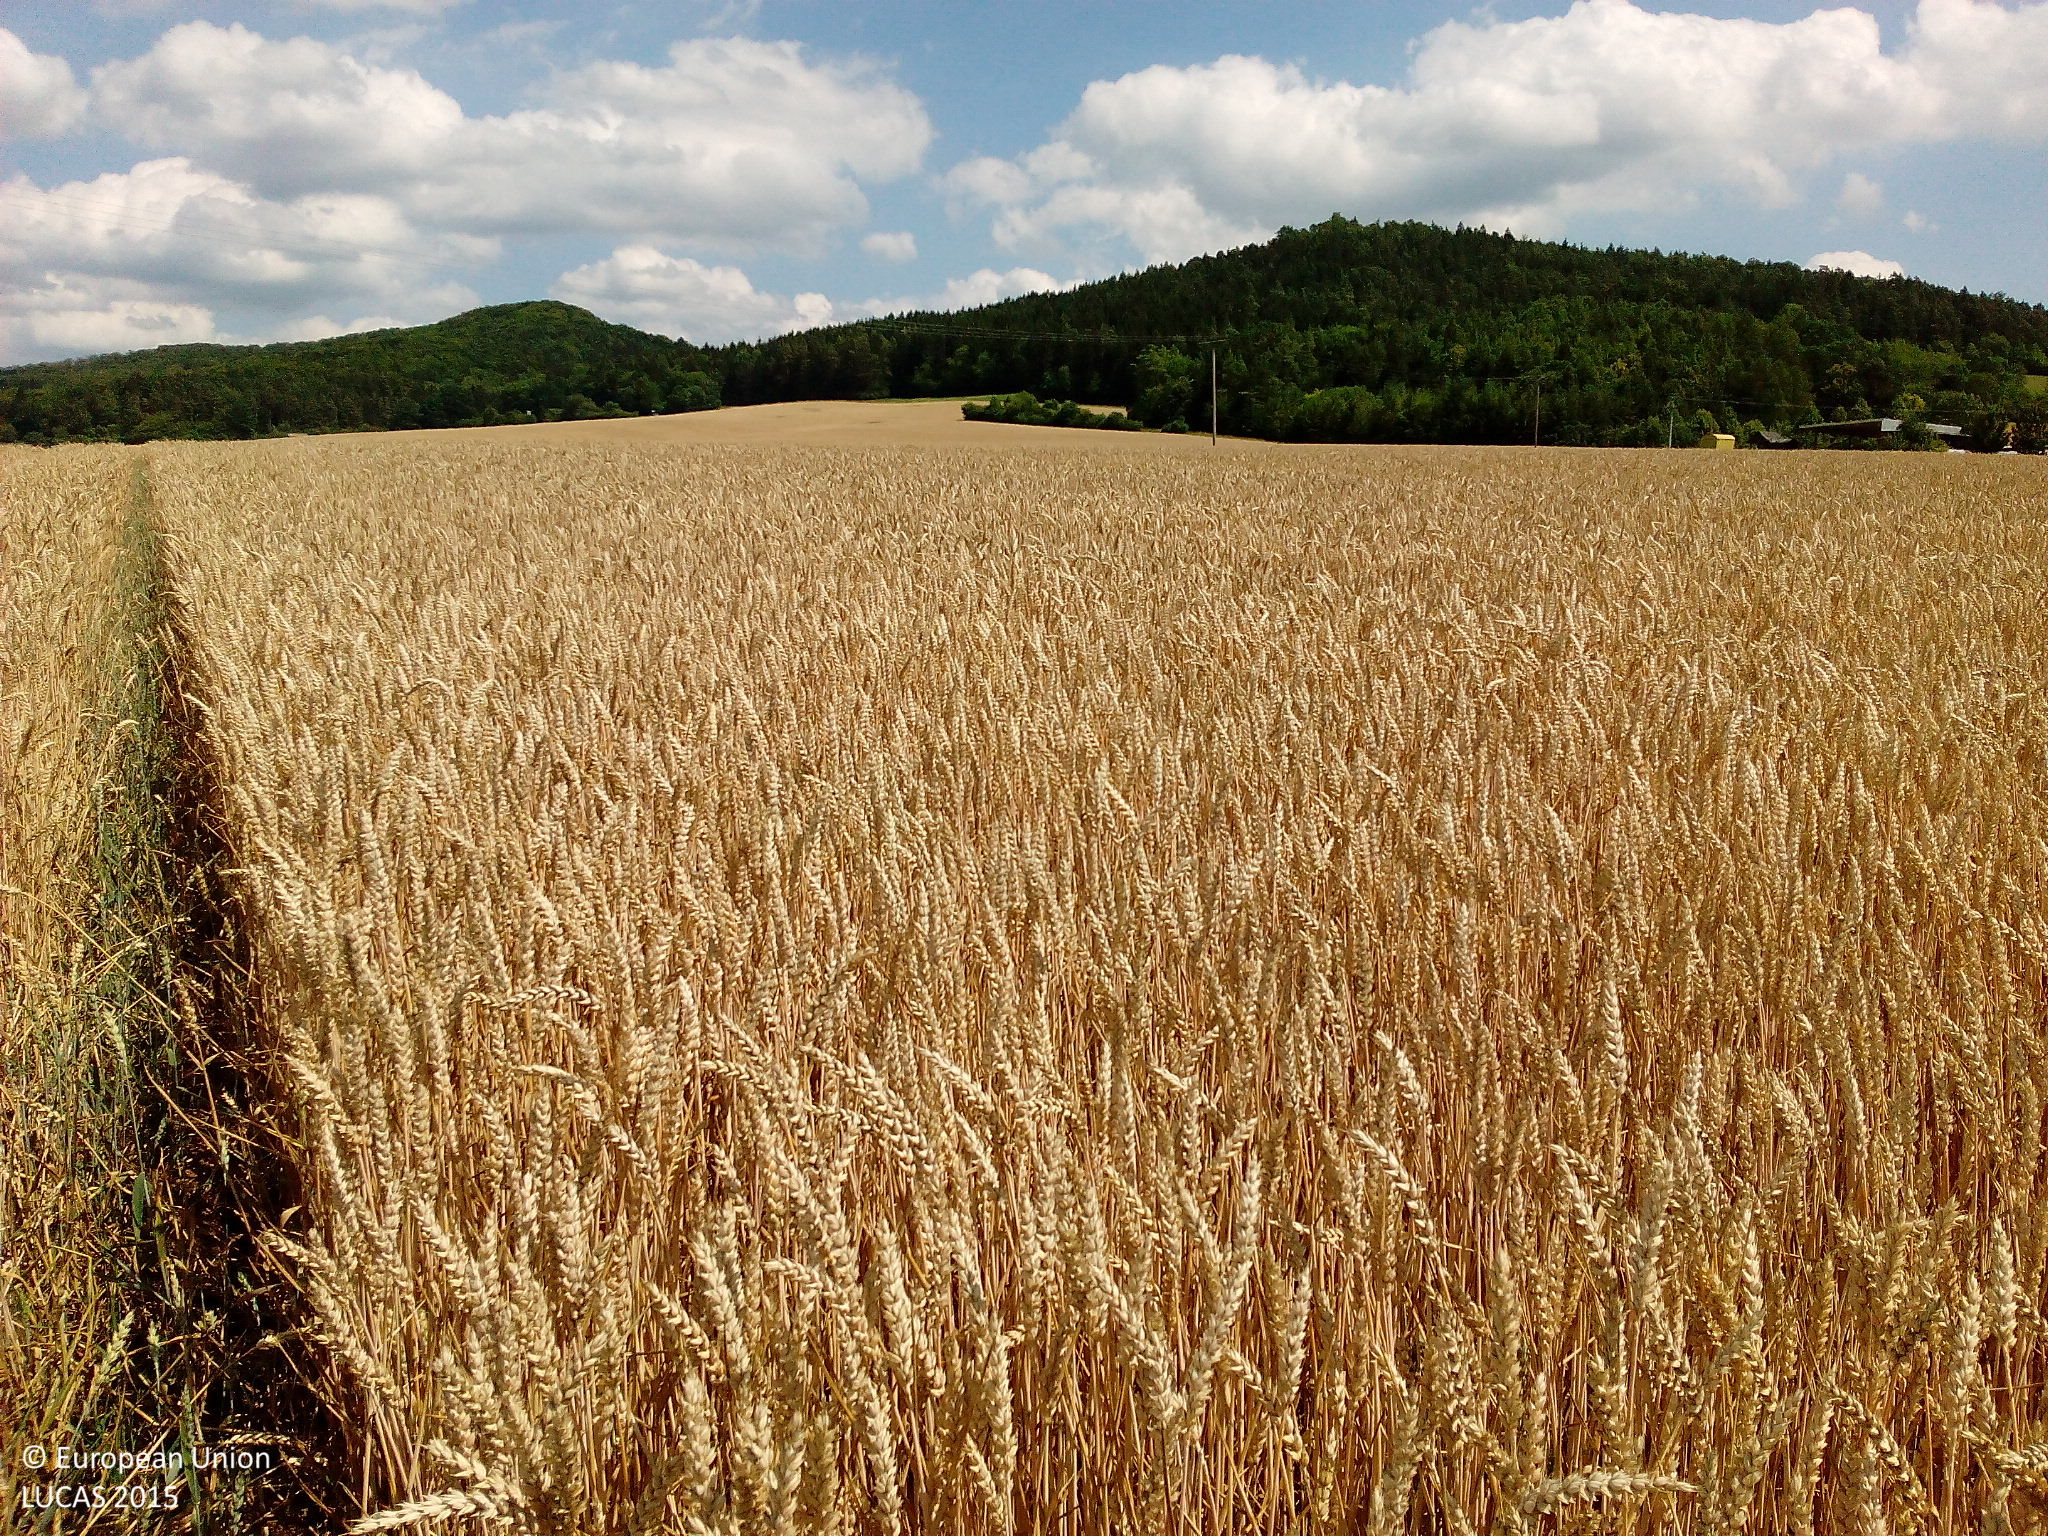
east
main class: Cropland
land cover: Common wheat
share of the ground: > 75 %
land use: Agriculture (excluding fallow land and kitchen gardens)
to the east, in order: Common wheat; Electric lines; Common wheat
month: July
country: DE
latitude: 50.7596
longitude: 9.9575
